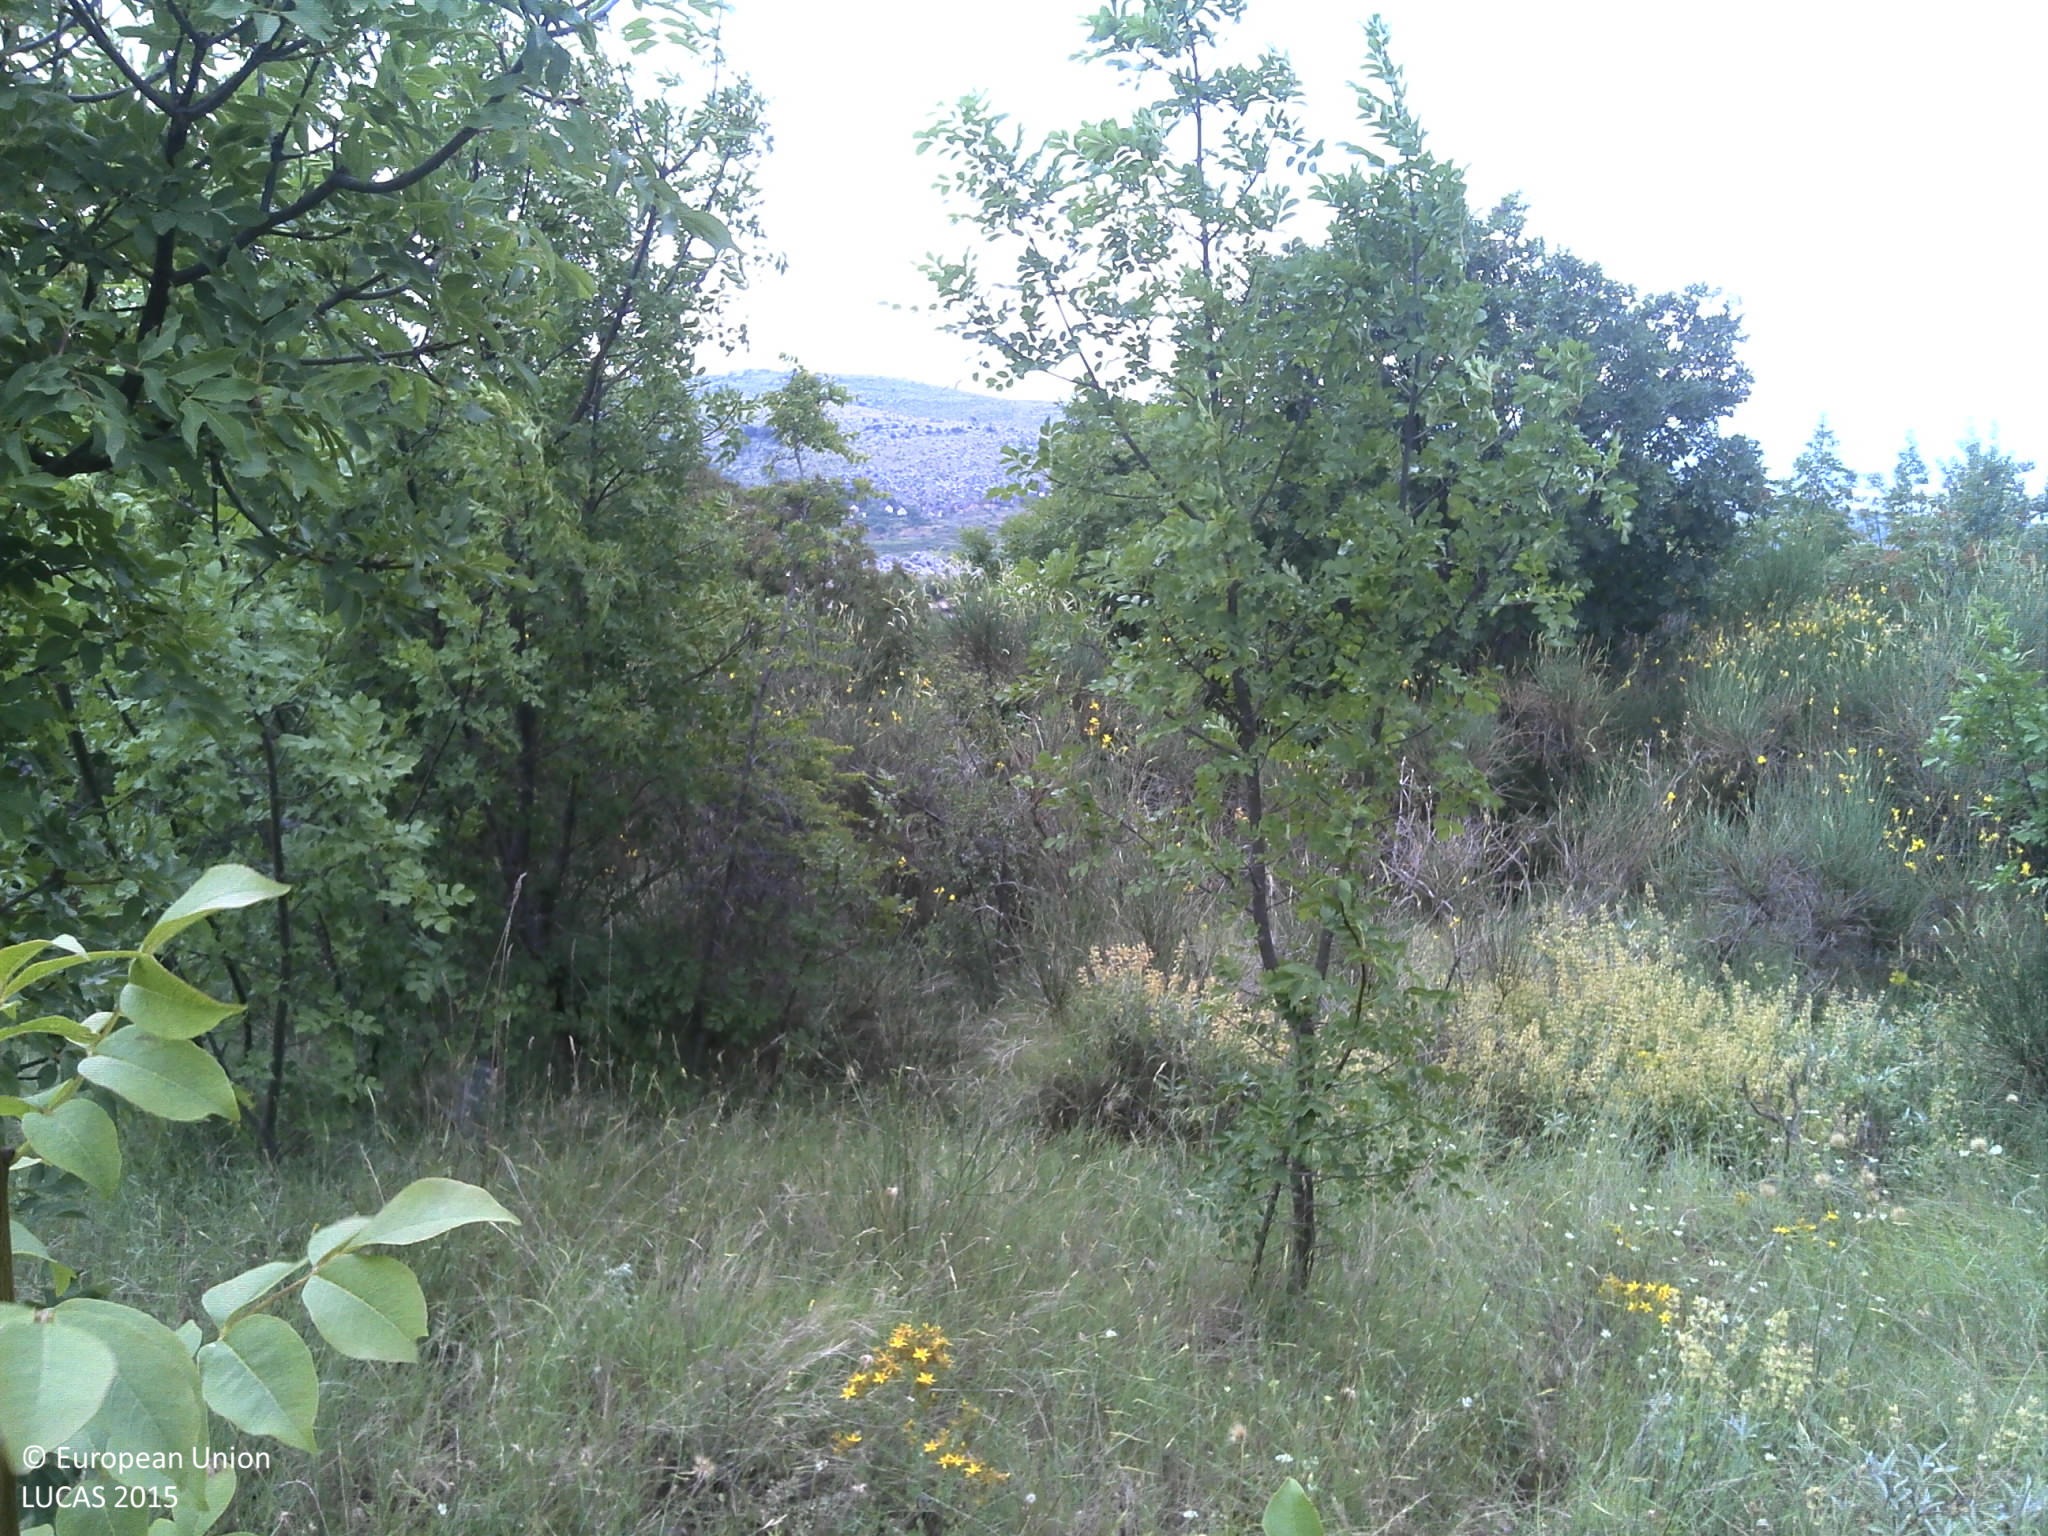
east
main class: Shrubland
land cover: Shrubland with sparse tree cover
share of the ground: 25 - 50 %
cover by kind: shrubs 40 %, herbaceous plants 25 %, consolidated bare surface 15 %, unconsolidated bare surface 15 %, broadleaved forest trees 5 %
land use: Semi-natural and natural areas not in use
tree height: < 5 m
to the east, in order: Shrubland with sparse tree cover; Dry stone walls; Shrubland with sparse tree cover; Dry stone walls; Shrubland with sparse tree cover; Dry stone walls; Shrubland with sparse tree cover; Dry stone walls; Broadleaved woodland; Dry stone walls; Olive groves; Dry stone walls; Shrubland with sparse tree cover; Dry stone walls; Olive groves; Dry stone walls; Shrubland with sparse tree cover; Dry stone walls; Grassland without tree/shrub cover; Electric lines; Grassland without tree/shrub cover; Tracks; Dry stone walls; Shrubland with sparse tree cover
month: June
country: HR
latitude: 43.5311
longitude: 16.2146
